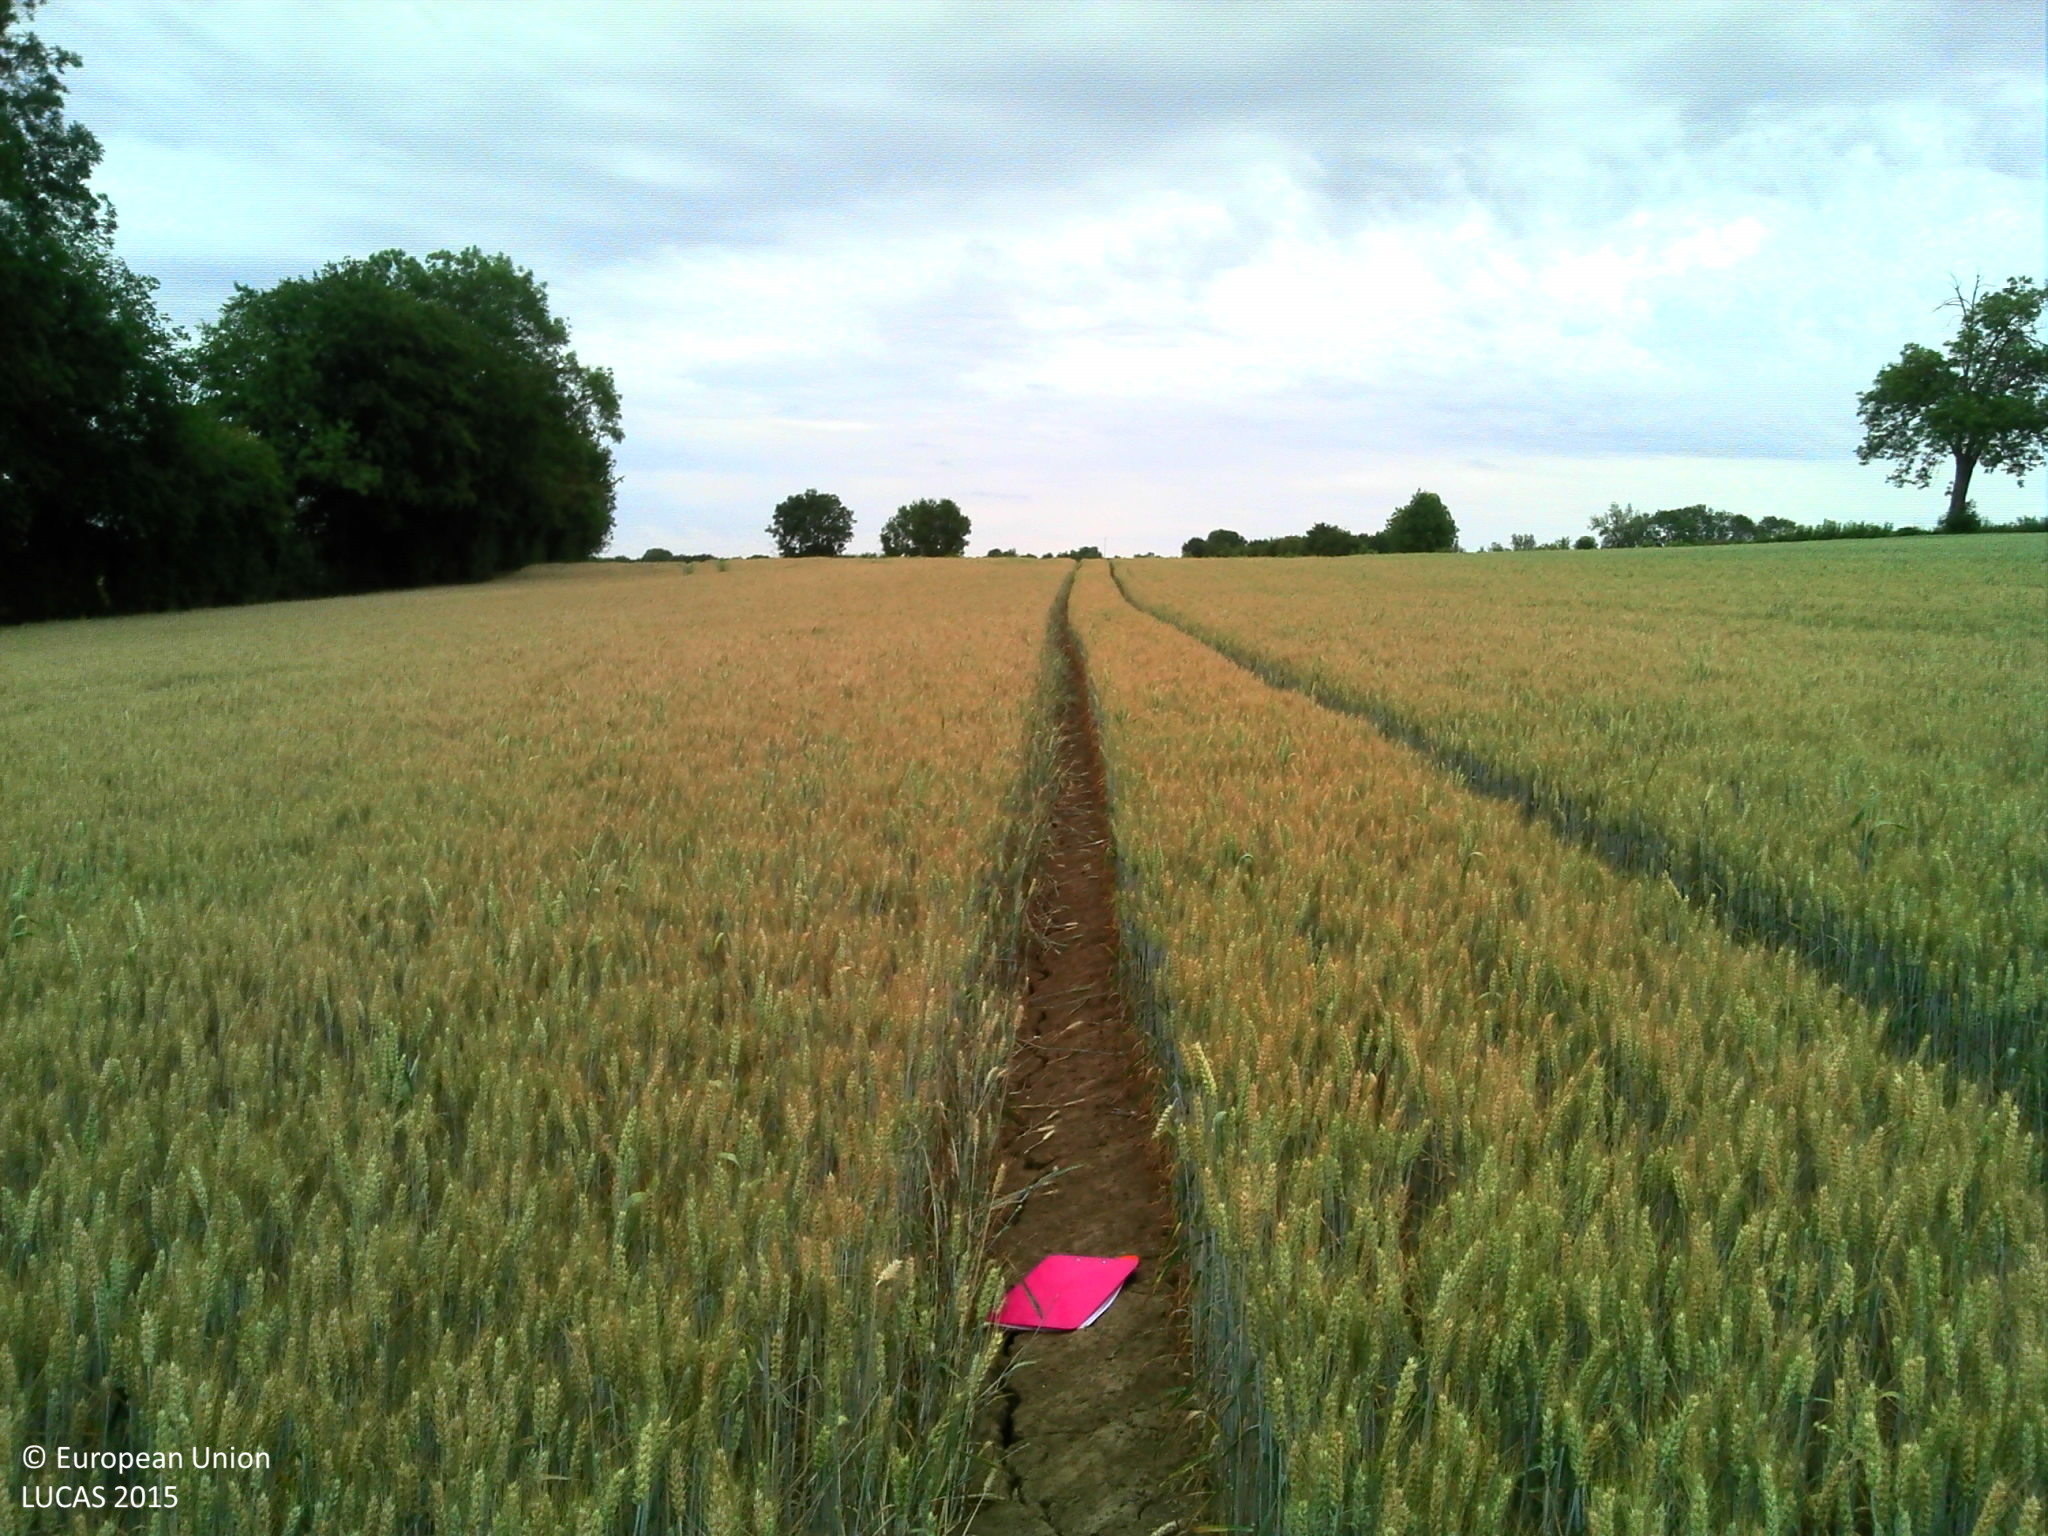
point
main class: Cropland
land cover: Common wheat
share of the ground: > 75 %
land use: Agriculture (excluding fallow land and kitchen gardens)
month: July
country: FR
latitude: 49.4906
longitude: 1.7971
